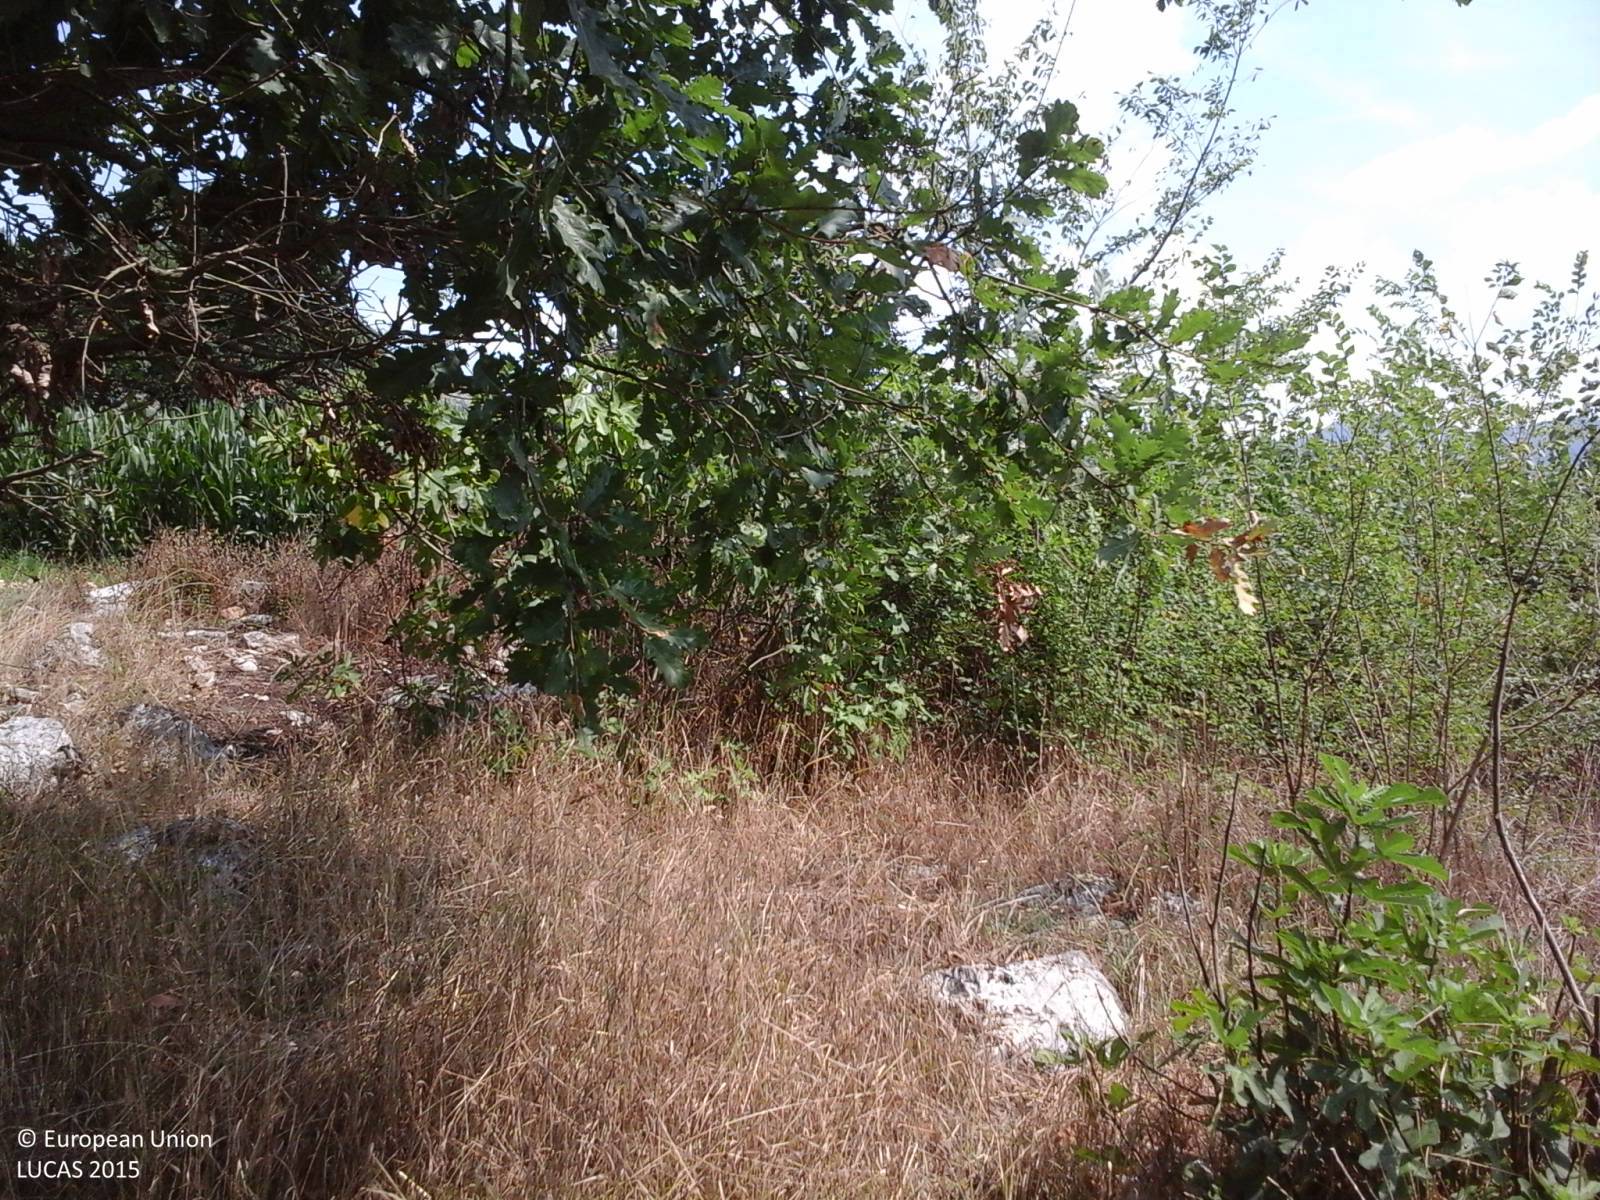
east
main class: Grassland
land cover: Grassland with sparse tree/shrub cover
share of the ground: > 75 %
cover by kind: herbaceous plants 75 %, unconsolidated bare surface 20 %, broadleaved forest trees 5 %
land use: Semi-natural and natural areas not in use
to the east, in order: Grassland with sparse tree/shrub cover; Single bushes/trees; Rock outcrops; Maize; Electric lines; Maize; Grass margins; Dry stone walls; Paved roads, cycling and walking lanes; Abandoned hedges; Vineyards; Spontaneously vegetated surfaces; Abandoned hedges; Maize
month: August
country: IT
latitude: 41.4782
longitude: 13.3282
